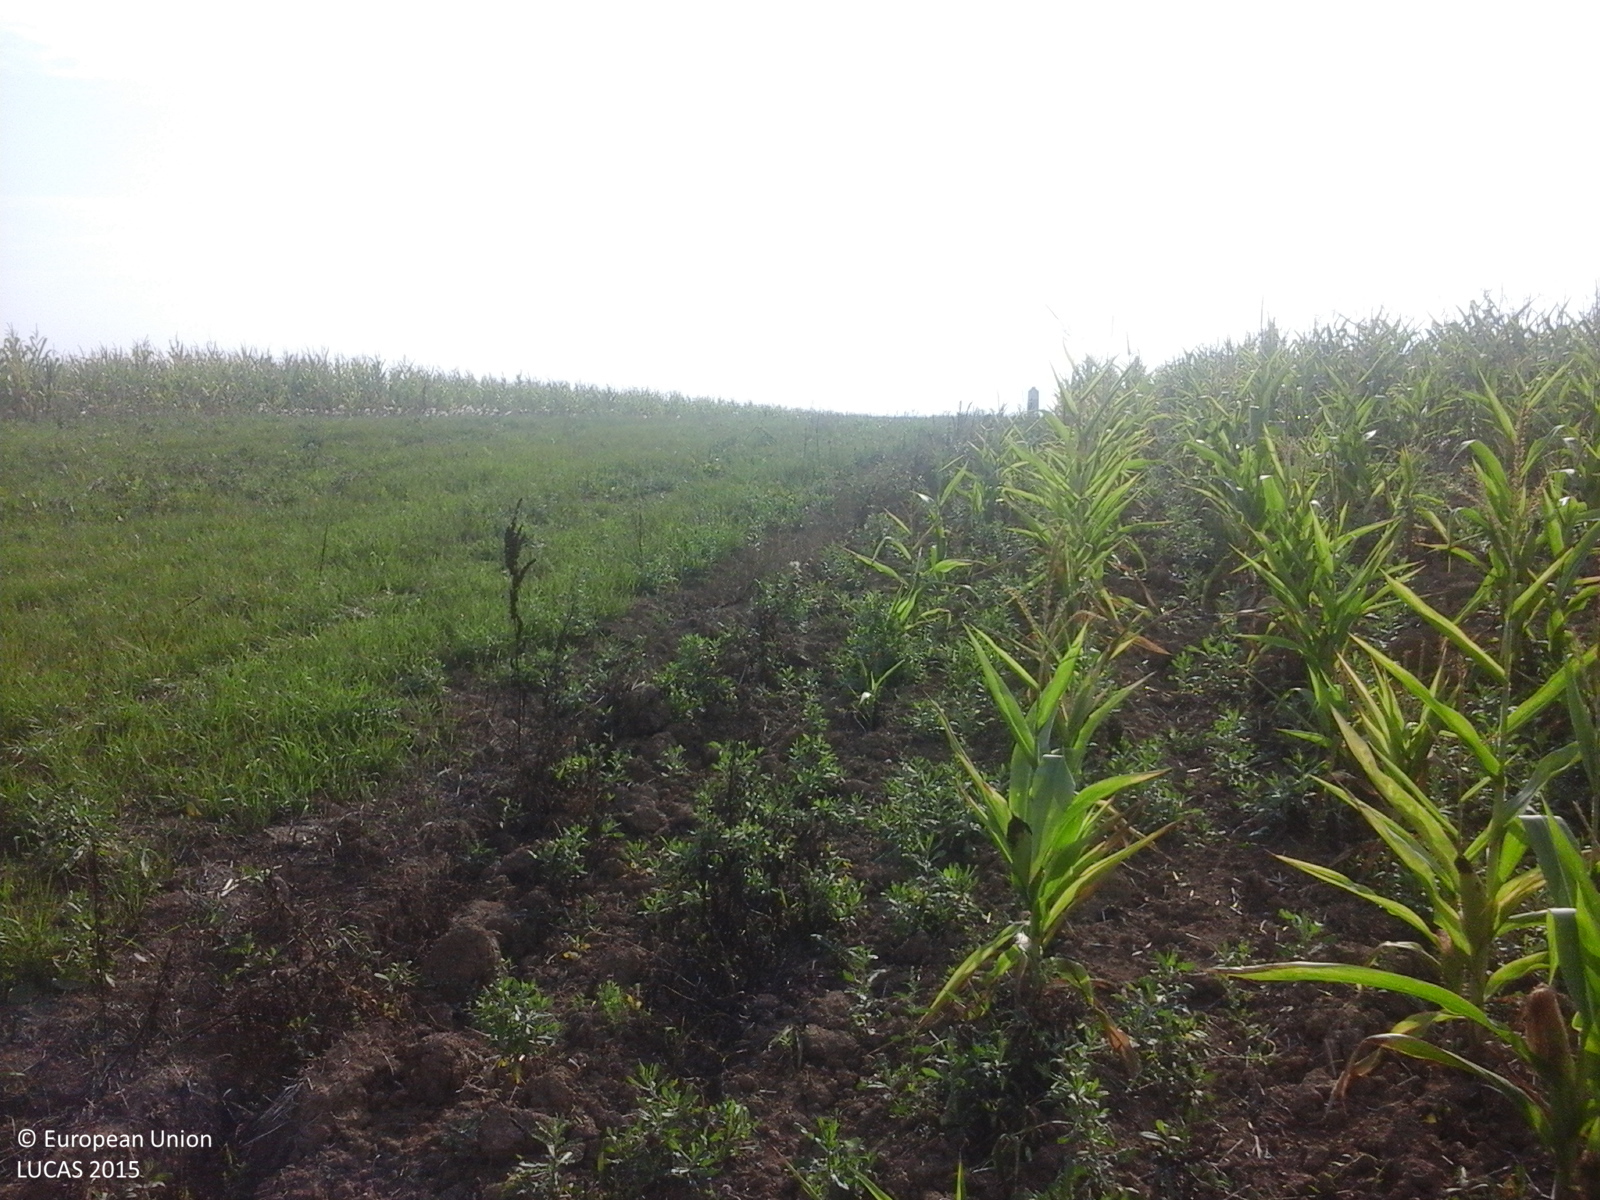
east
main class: Cropland
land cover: Maize
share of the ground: > 75 %
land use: Agriculture (excluding fallow land and kitchen gardens)
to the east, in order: Maize; Grassland without tree/shrub cover; Grass margins; Tracks; Grass margins; Maize
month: August
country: RO
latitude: 46.4248
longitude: 21.9495
